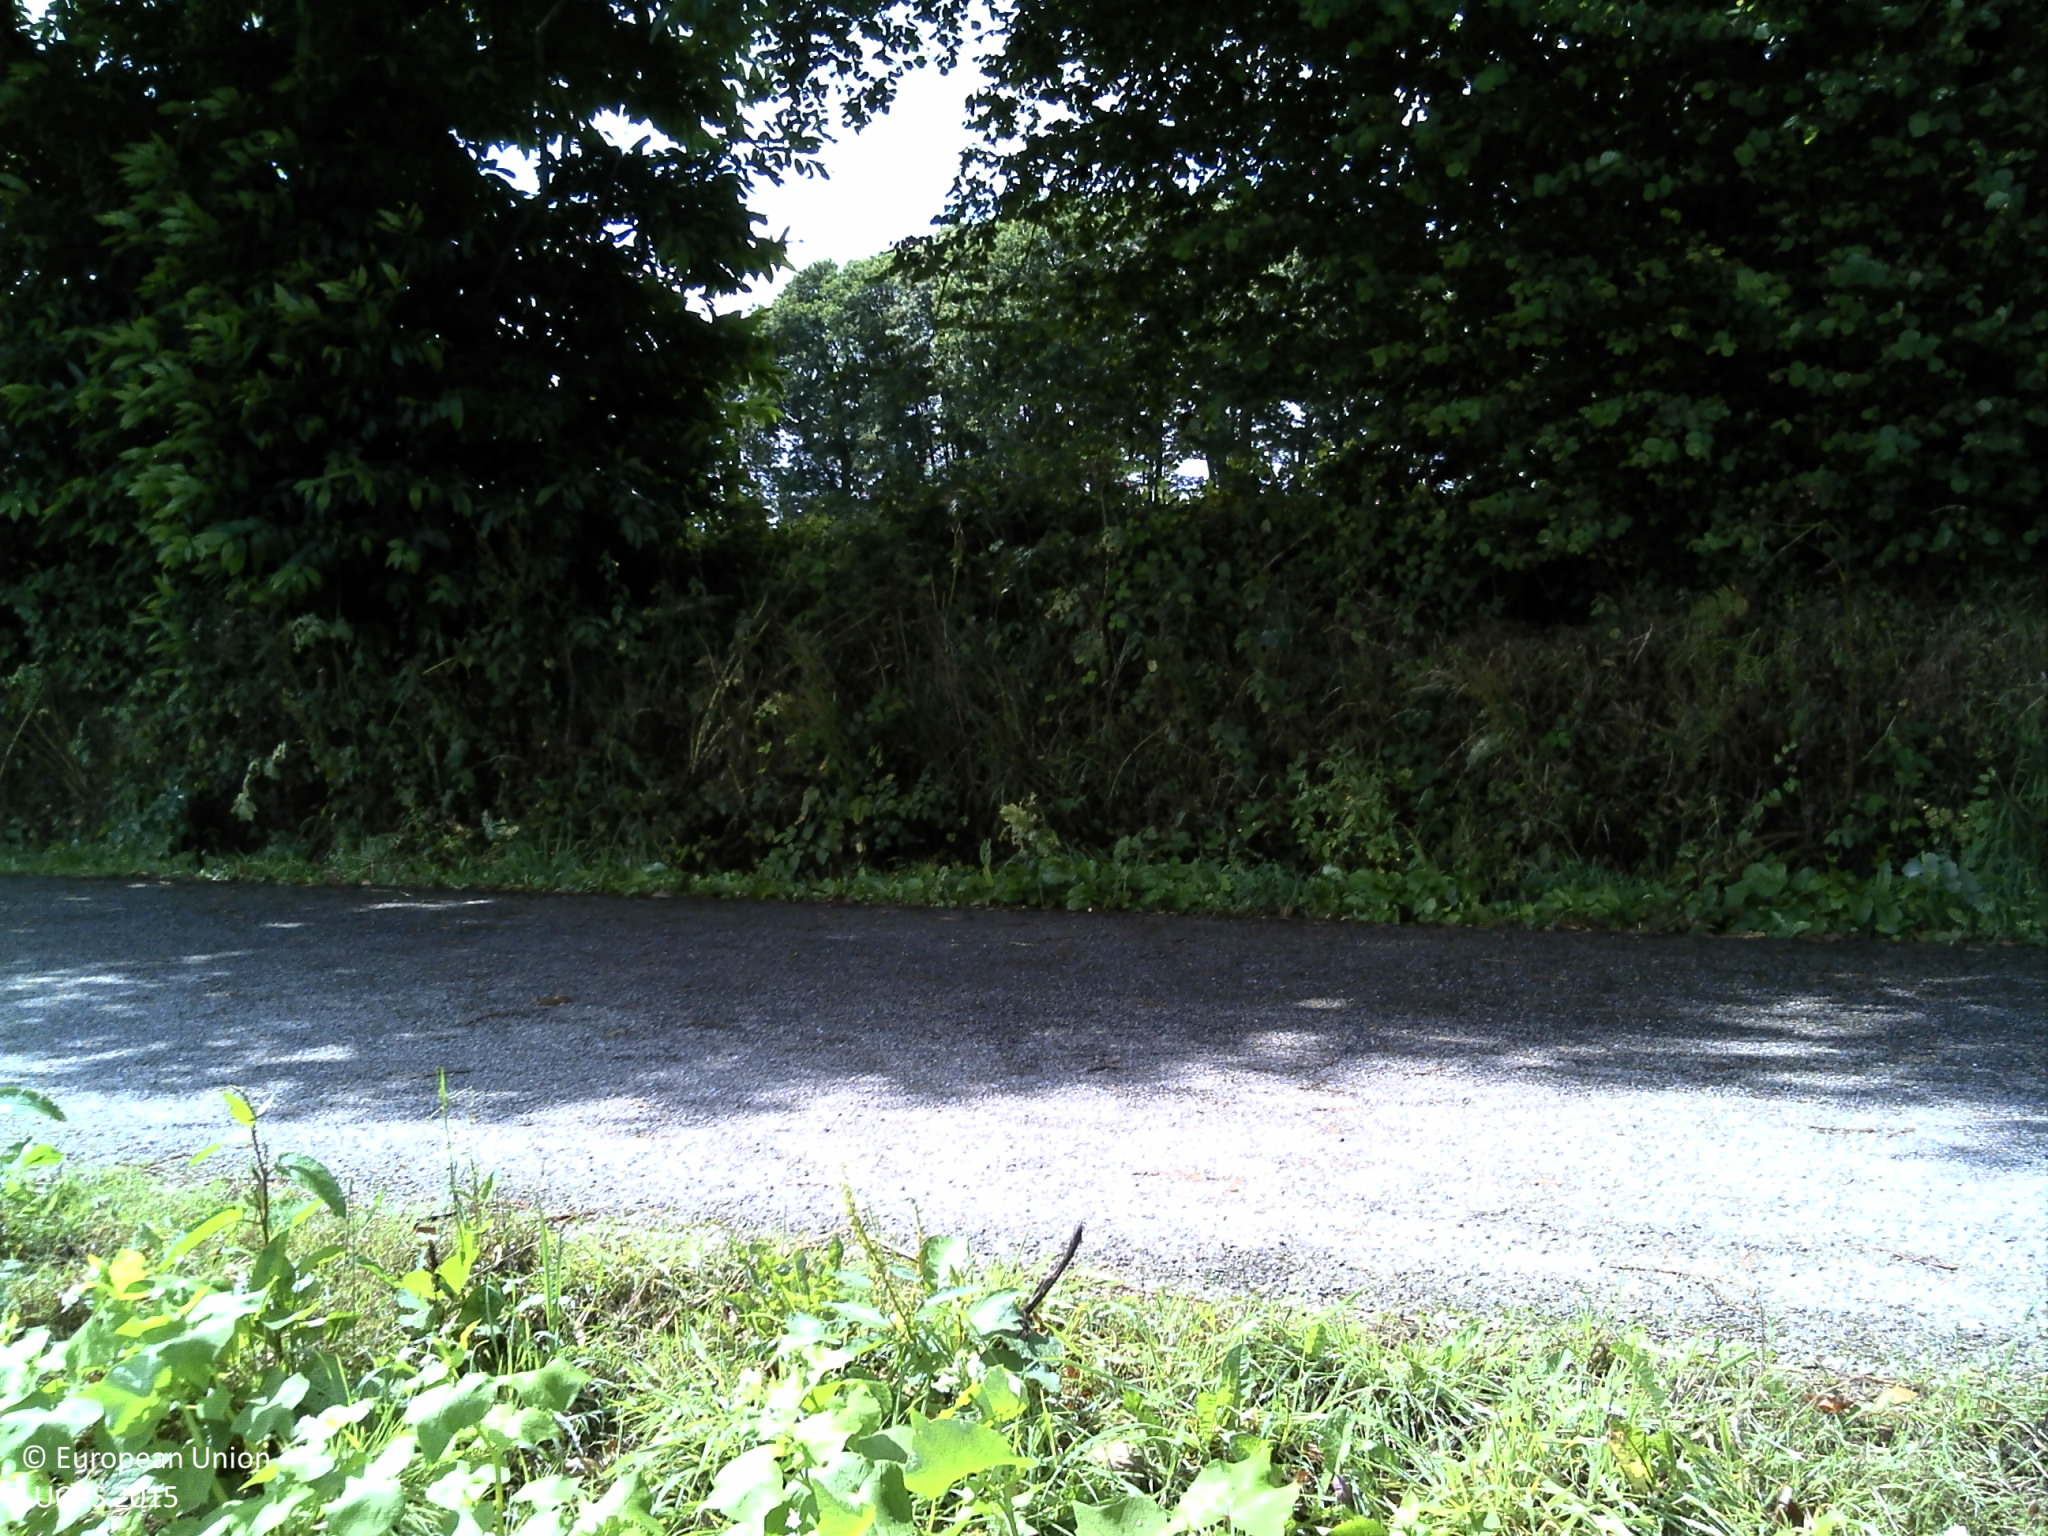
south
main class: Cropland
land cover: Other cereals
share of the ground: > 75 %
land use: Agriculture (excluding fallow land and kitchen gardens)
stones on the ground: 10 - 25 %
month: July
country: FR
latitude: 48.0733
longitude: -4.1418
